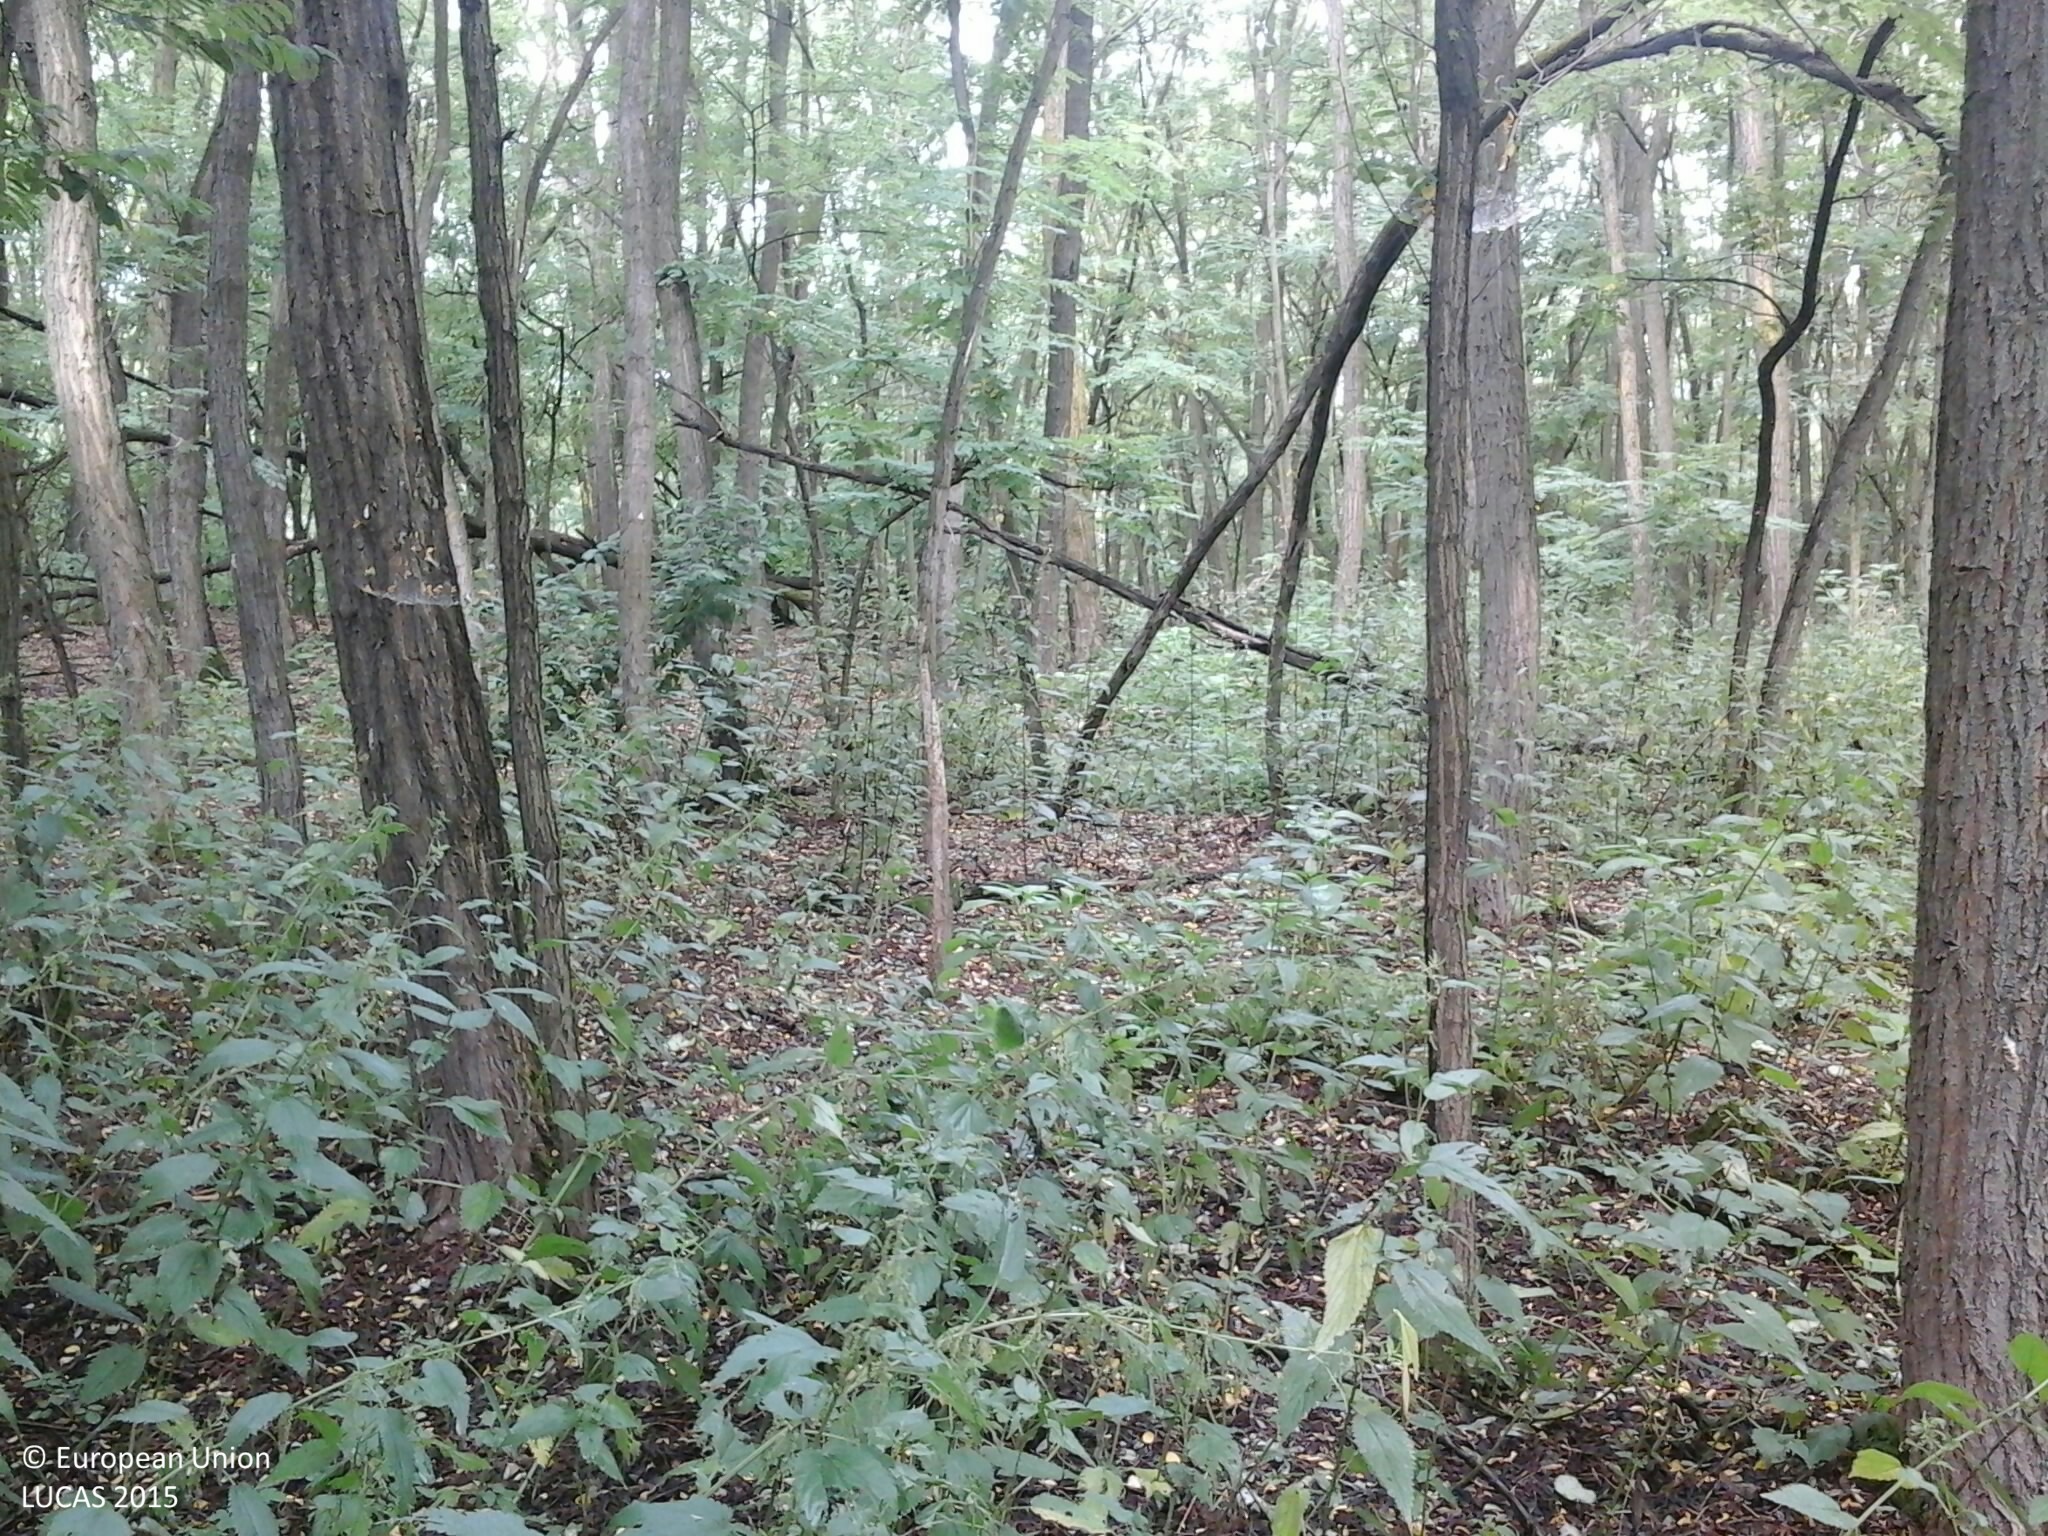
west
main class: Woodland
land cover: Broadleaved woodland
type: mesophytic deciduous forest
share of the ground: > 75 %
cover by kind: broadleaved forest trees 95 %, herbaceous plants 5 %
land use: Forestry
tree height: > 5 m
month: July
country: HU
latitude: 47.7543
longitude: 21.9355
